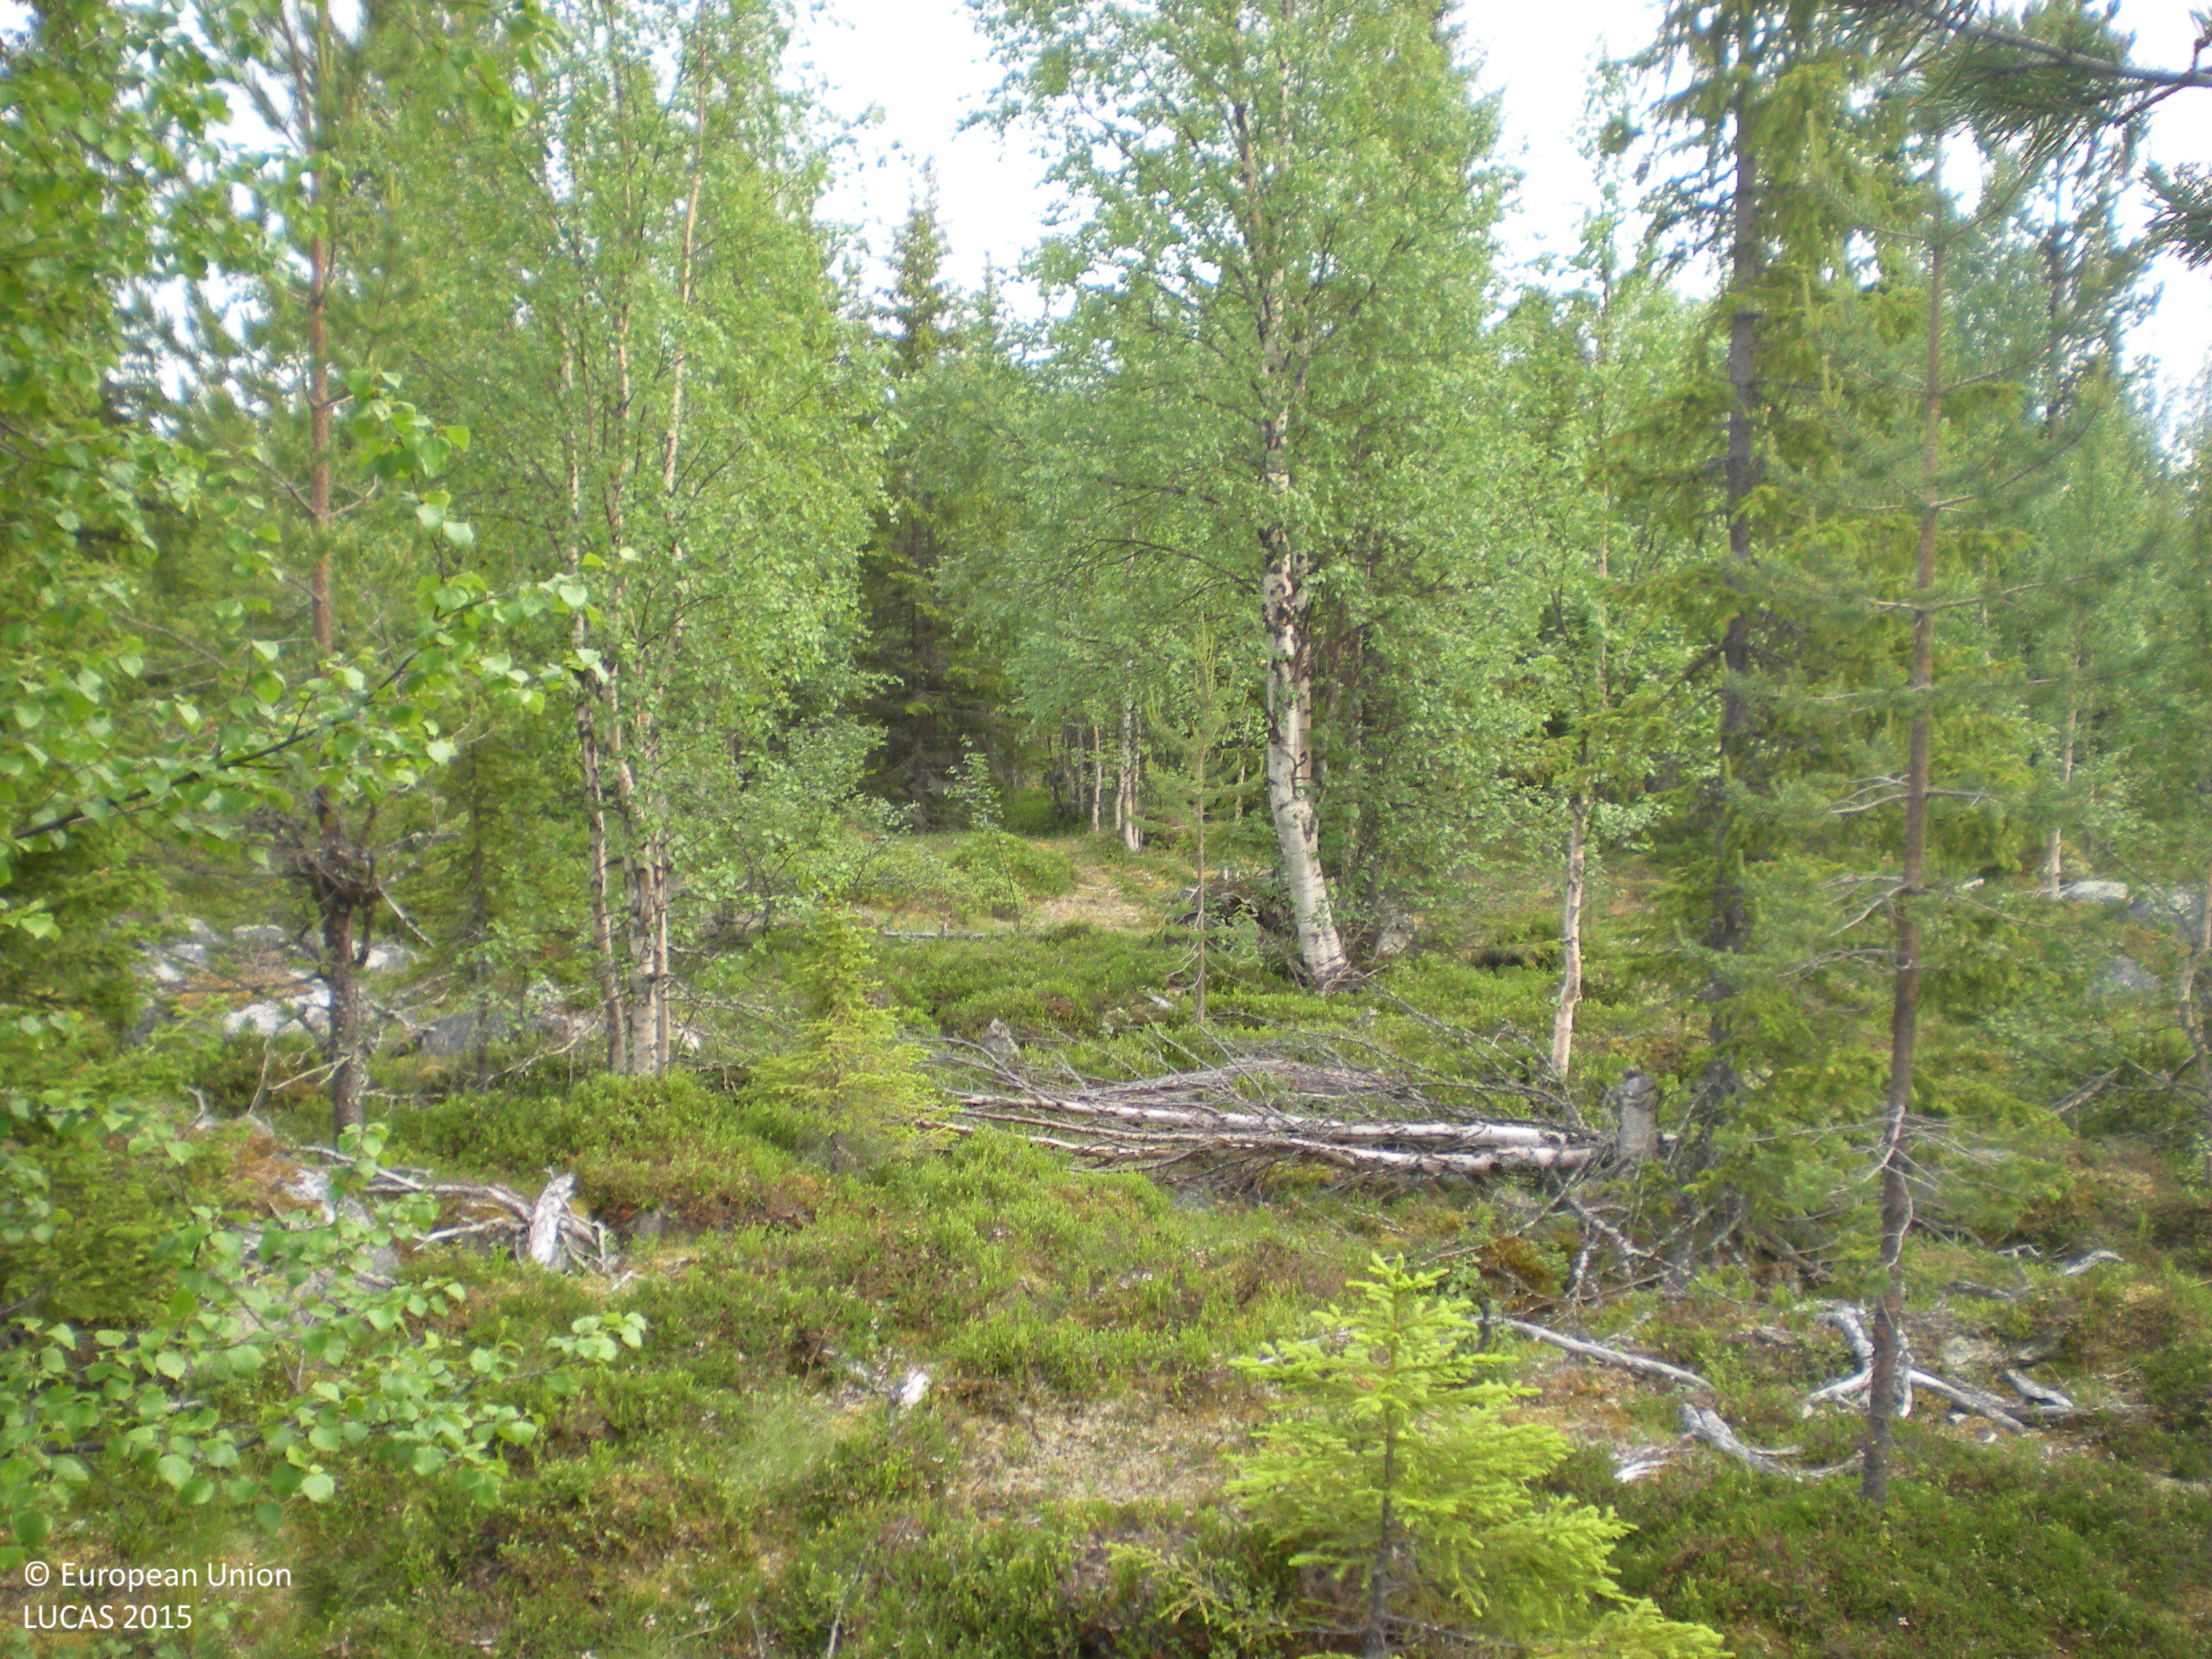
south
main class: Woodland
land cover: Other mixed woodland
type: boreal forest
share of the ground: 50 - 75 %
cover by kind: coniferous forest trees 40 %, shrubs 30 %, broadleaved forest trees 15 %, lichens and mosses 10 %, consolidated bare surface 5 %
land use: Forestry
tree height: > 5 m
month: July
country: SE
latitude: 65.6563
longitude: 17.0686
